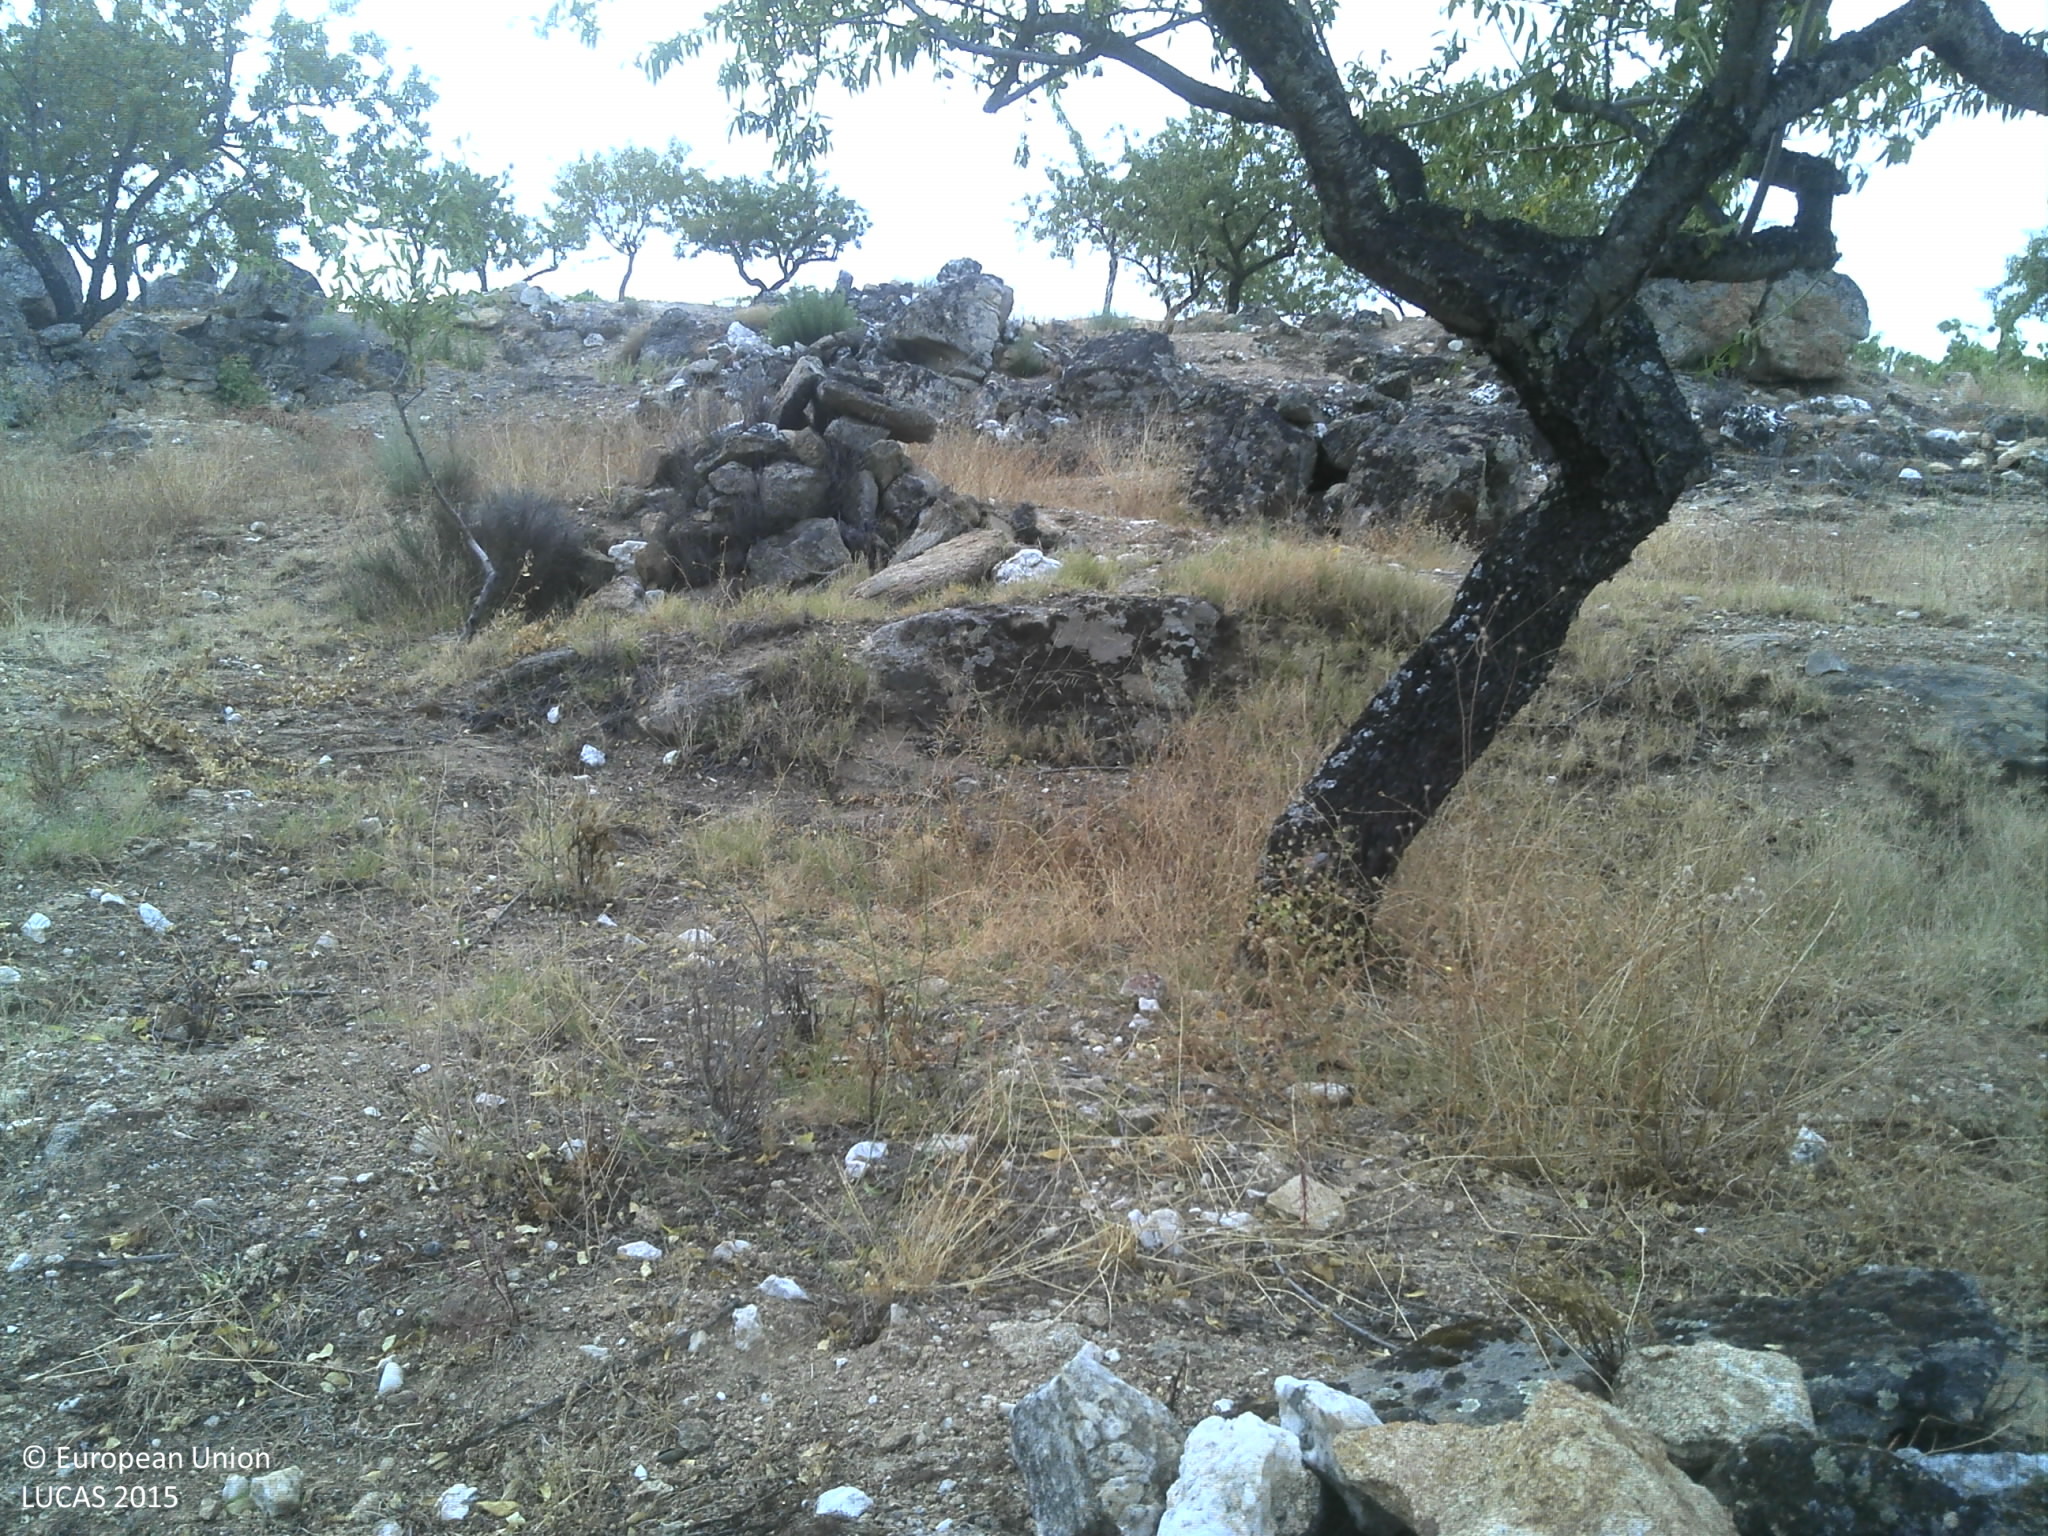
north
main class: Cropland
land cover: Nuts trees
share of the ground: 10 - 25 %
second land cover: Grassland without tree/shrub cover
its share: > 75 %
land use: Agriculture (excluding fallow land and kitchen gardens)
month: July
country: PT
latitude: 41.0880
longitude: -7.2446
